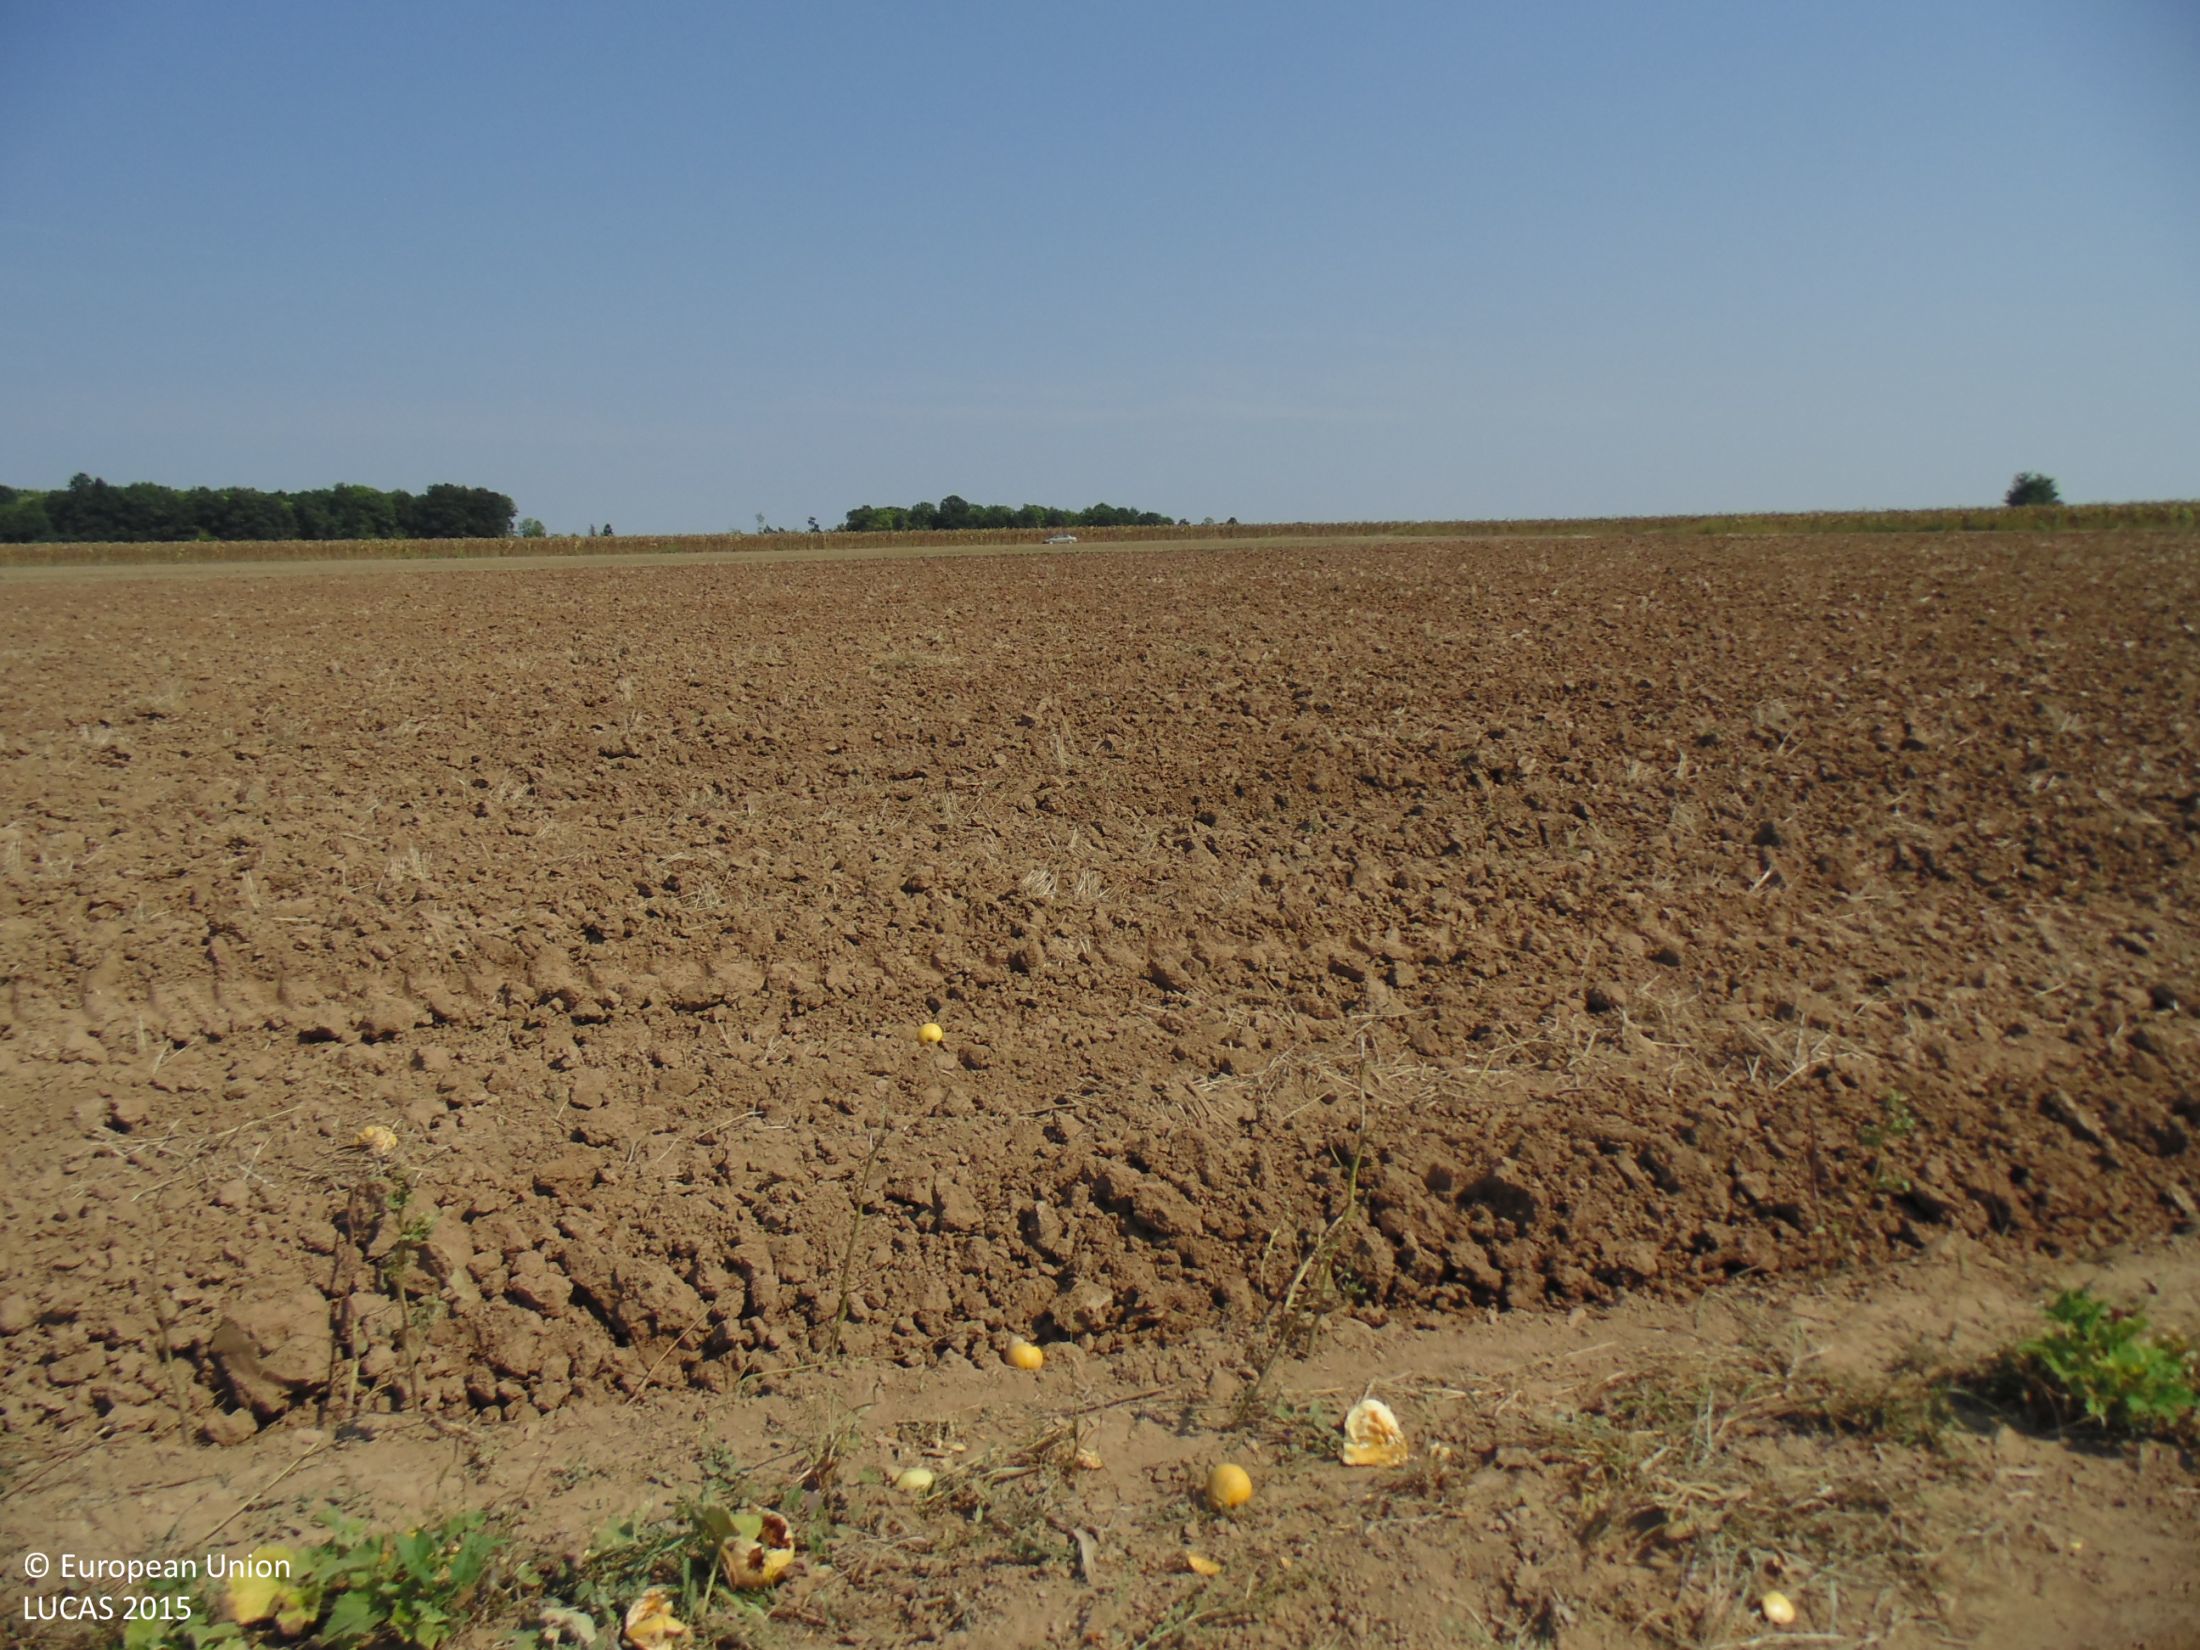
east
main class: Cropland
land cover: Other fresh vegetables
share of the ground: 25 - 50 %
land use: Agriculture (excluding fallow land and kitchen gardens)
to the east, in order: Other fresh vegetables; Common wheat; Spontaneously vegetated surfaces; Tracks; Grass margins; Sunflower
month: September
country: BG
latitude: 43.8453
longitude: 26.9496
